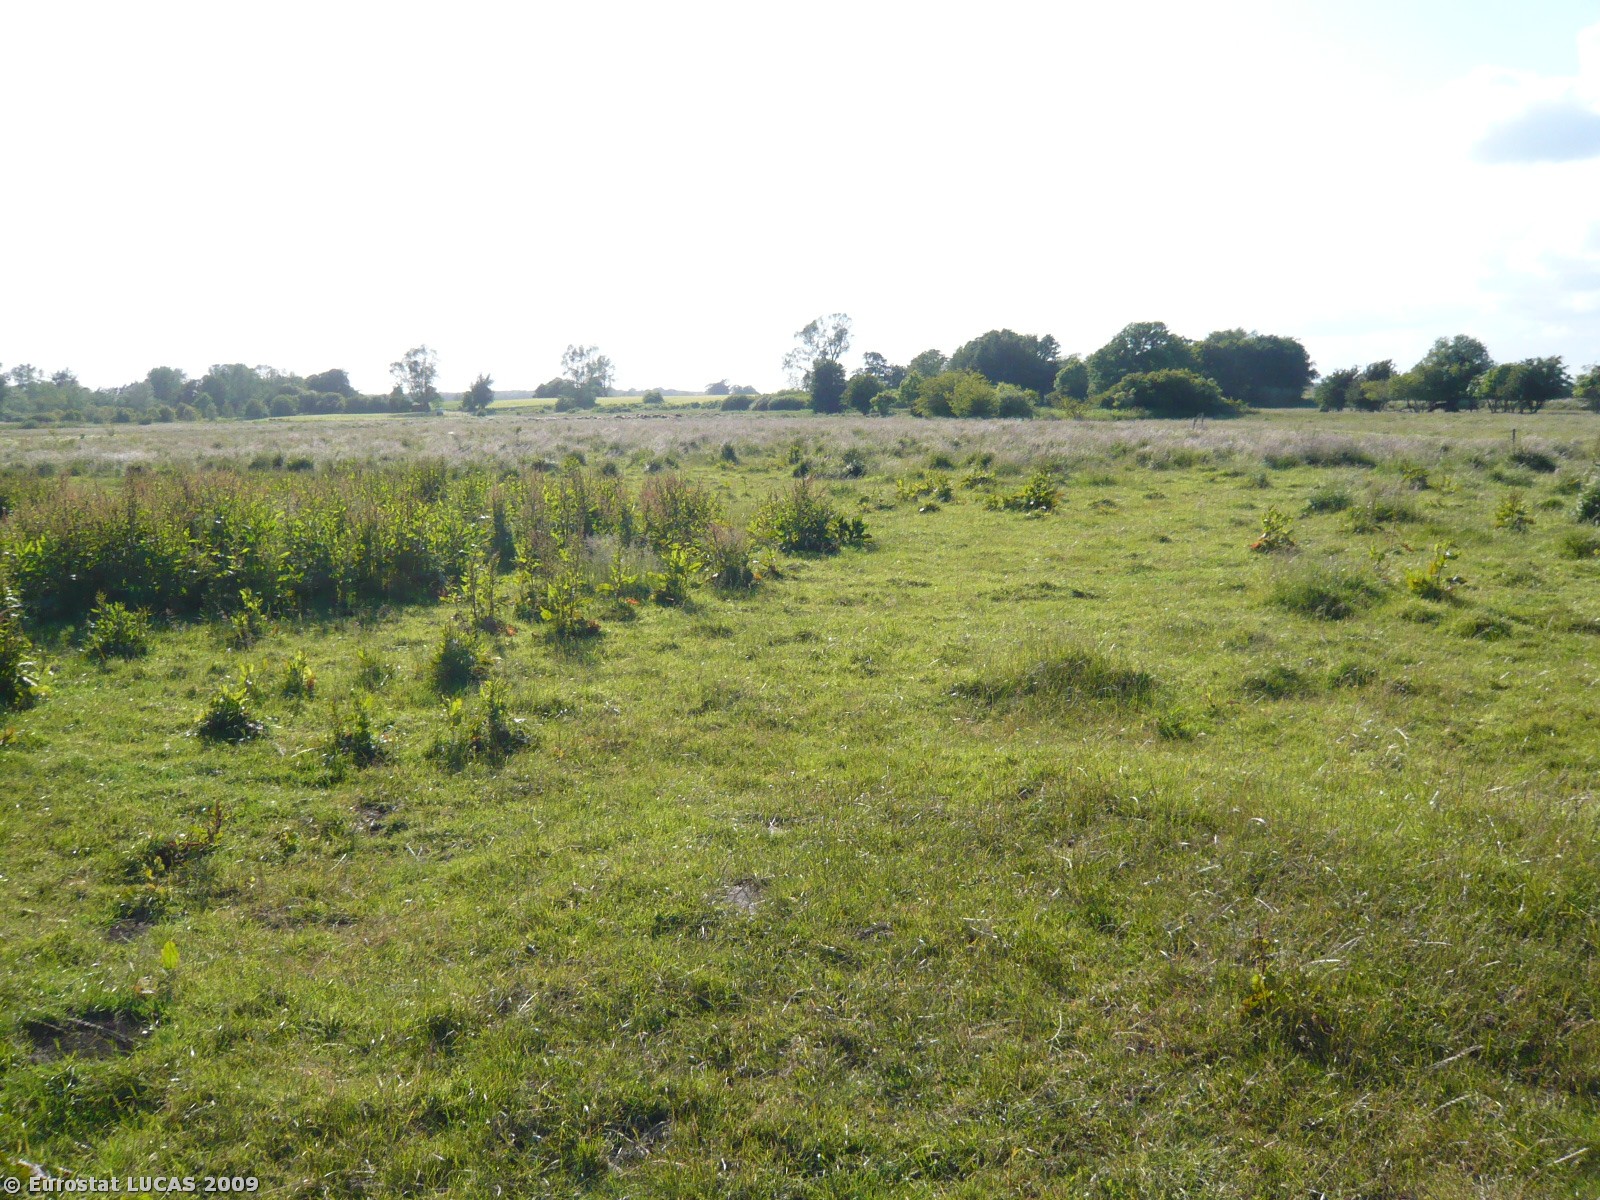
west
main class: Wetlands
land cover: Inland marshes
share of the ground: > 75 %
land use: Unused
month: June
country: DK
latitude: 54.6861
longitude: 11.5657
